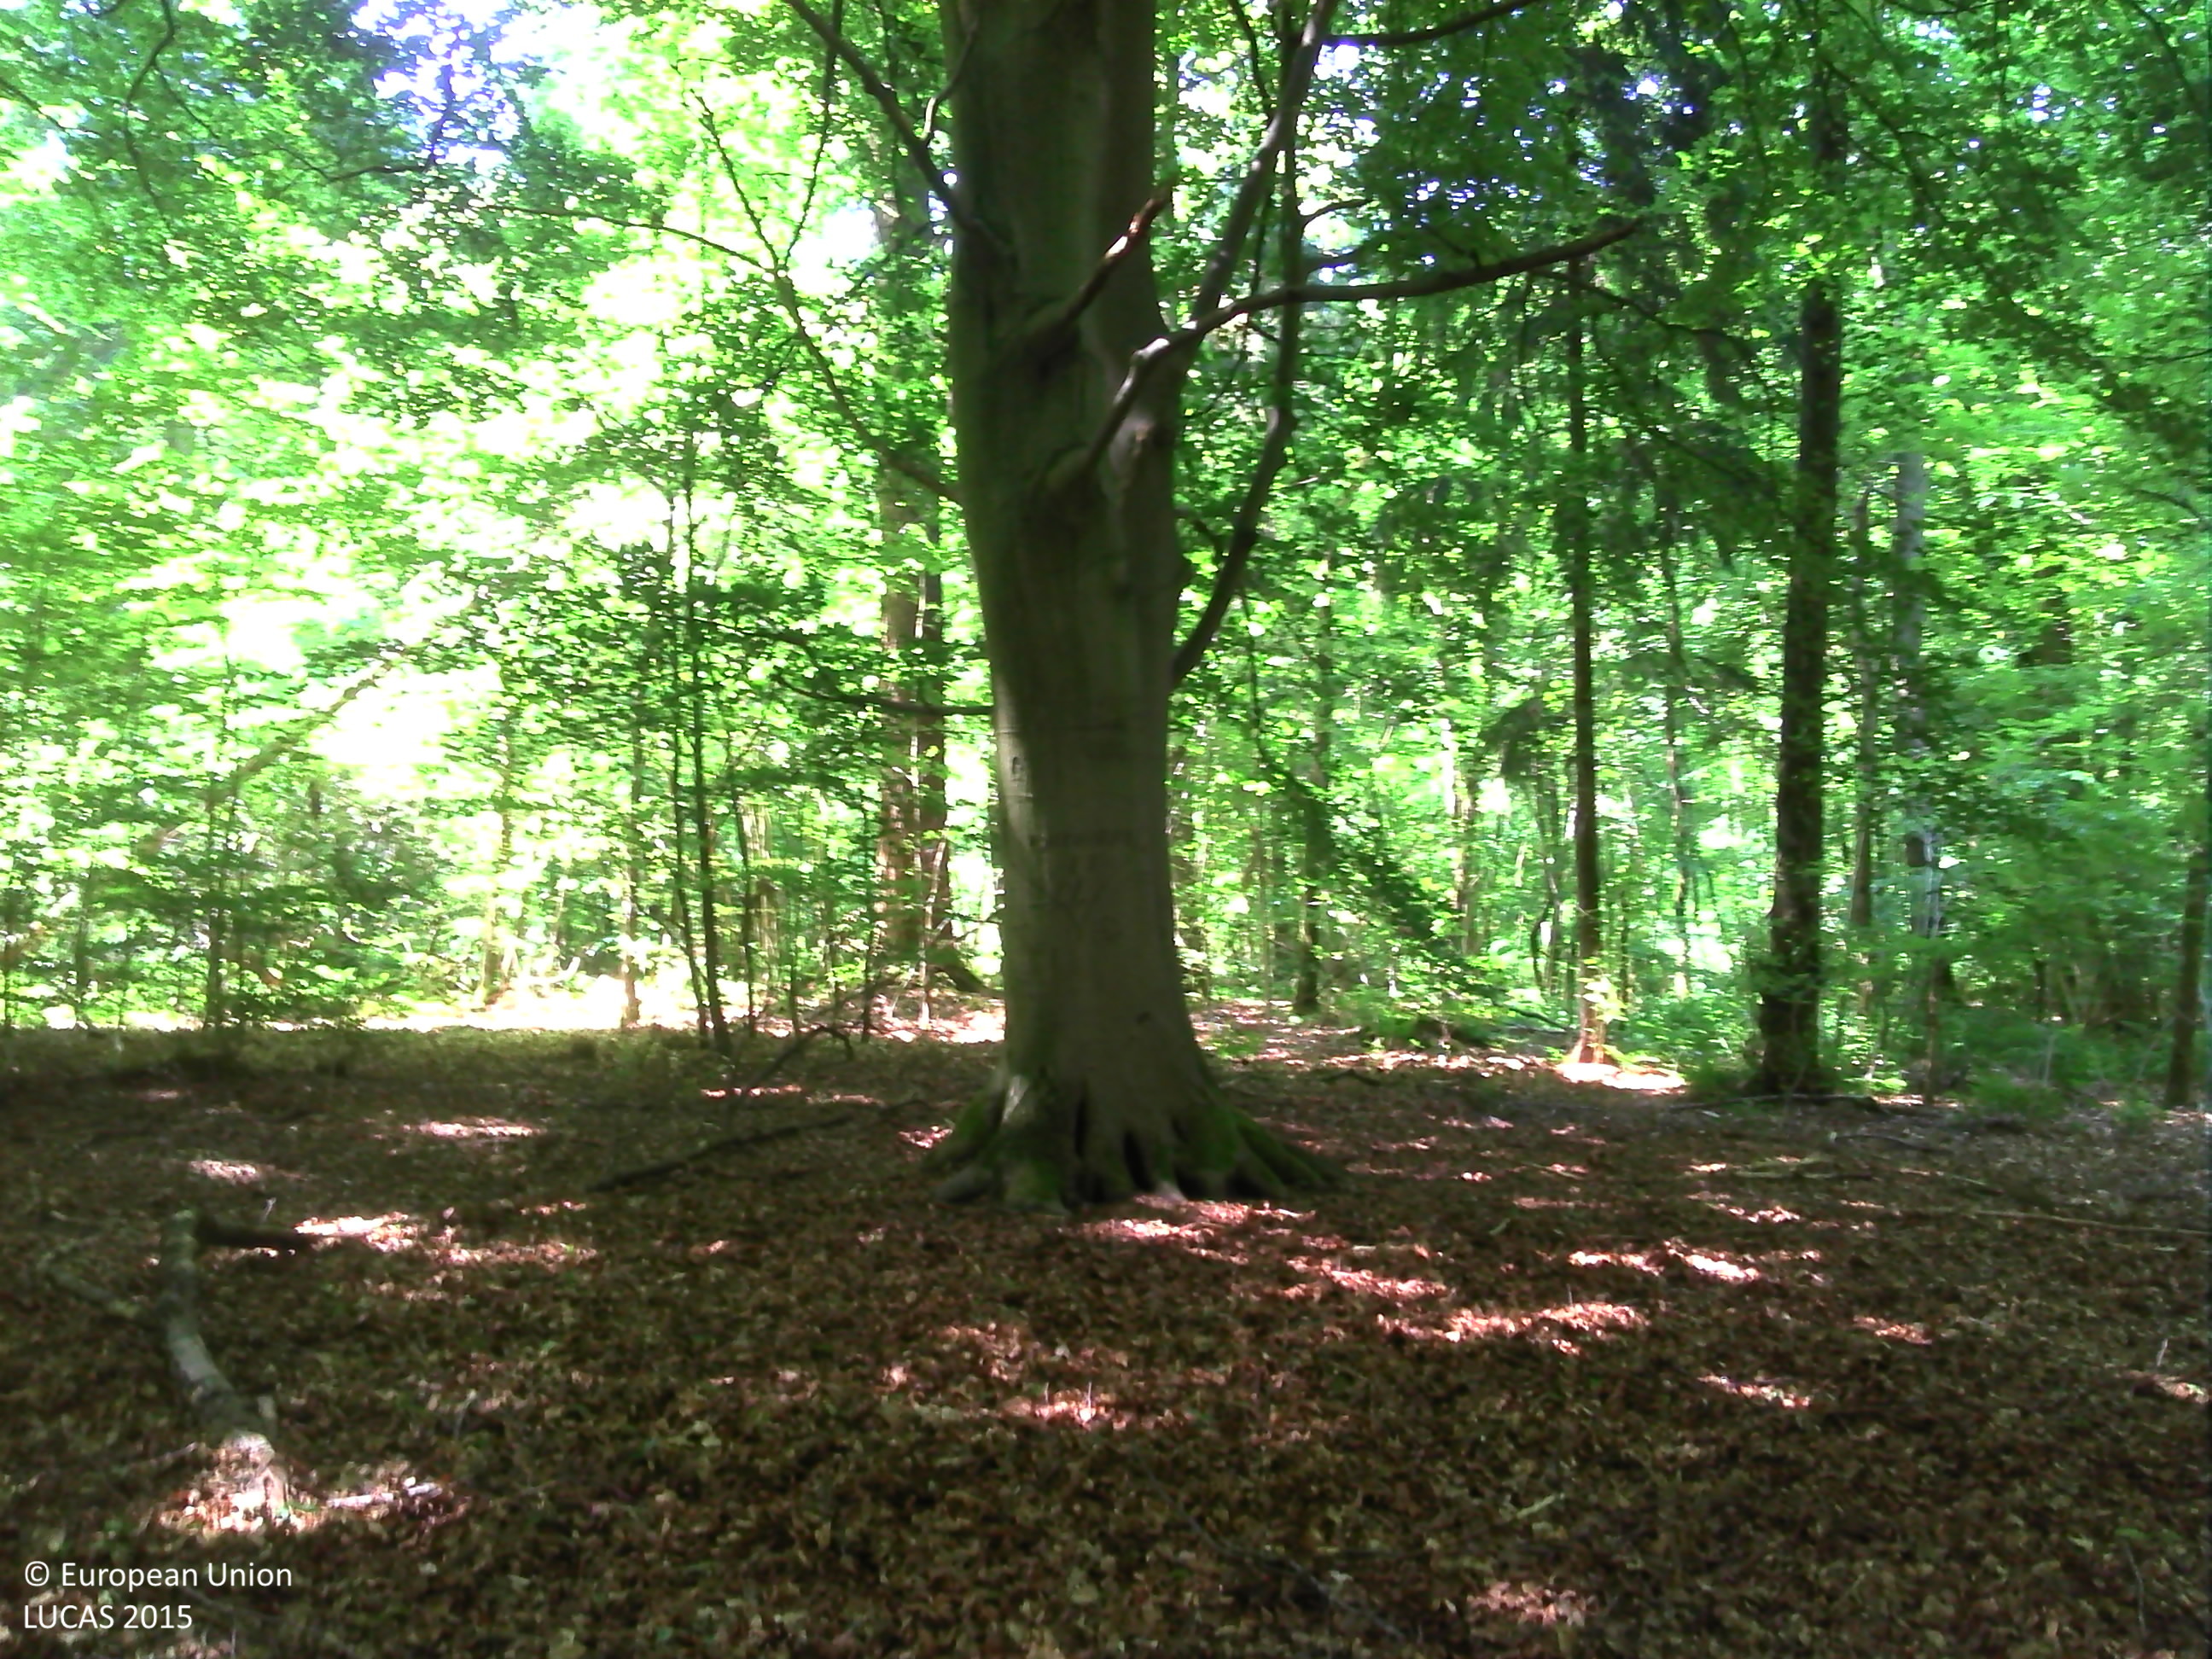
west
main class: Woodland
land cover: Broadleaved woodland
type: acidophilous oak and oak-birch forest
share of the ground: > 75 %
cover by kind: broadleaved forest trees 95 %, herbaceous plants 5 %
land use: Forestry
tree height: > 5 m
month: June
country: BE
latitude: 50.5646
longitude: 5.5229
